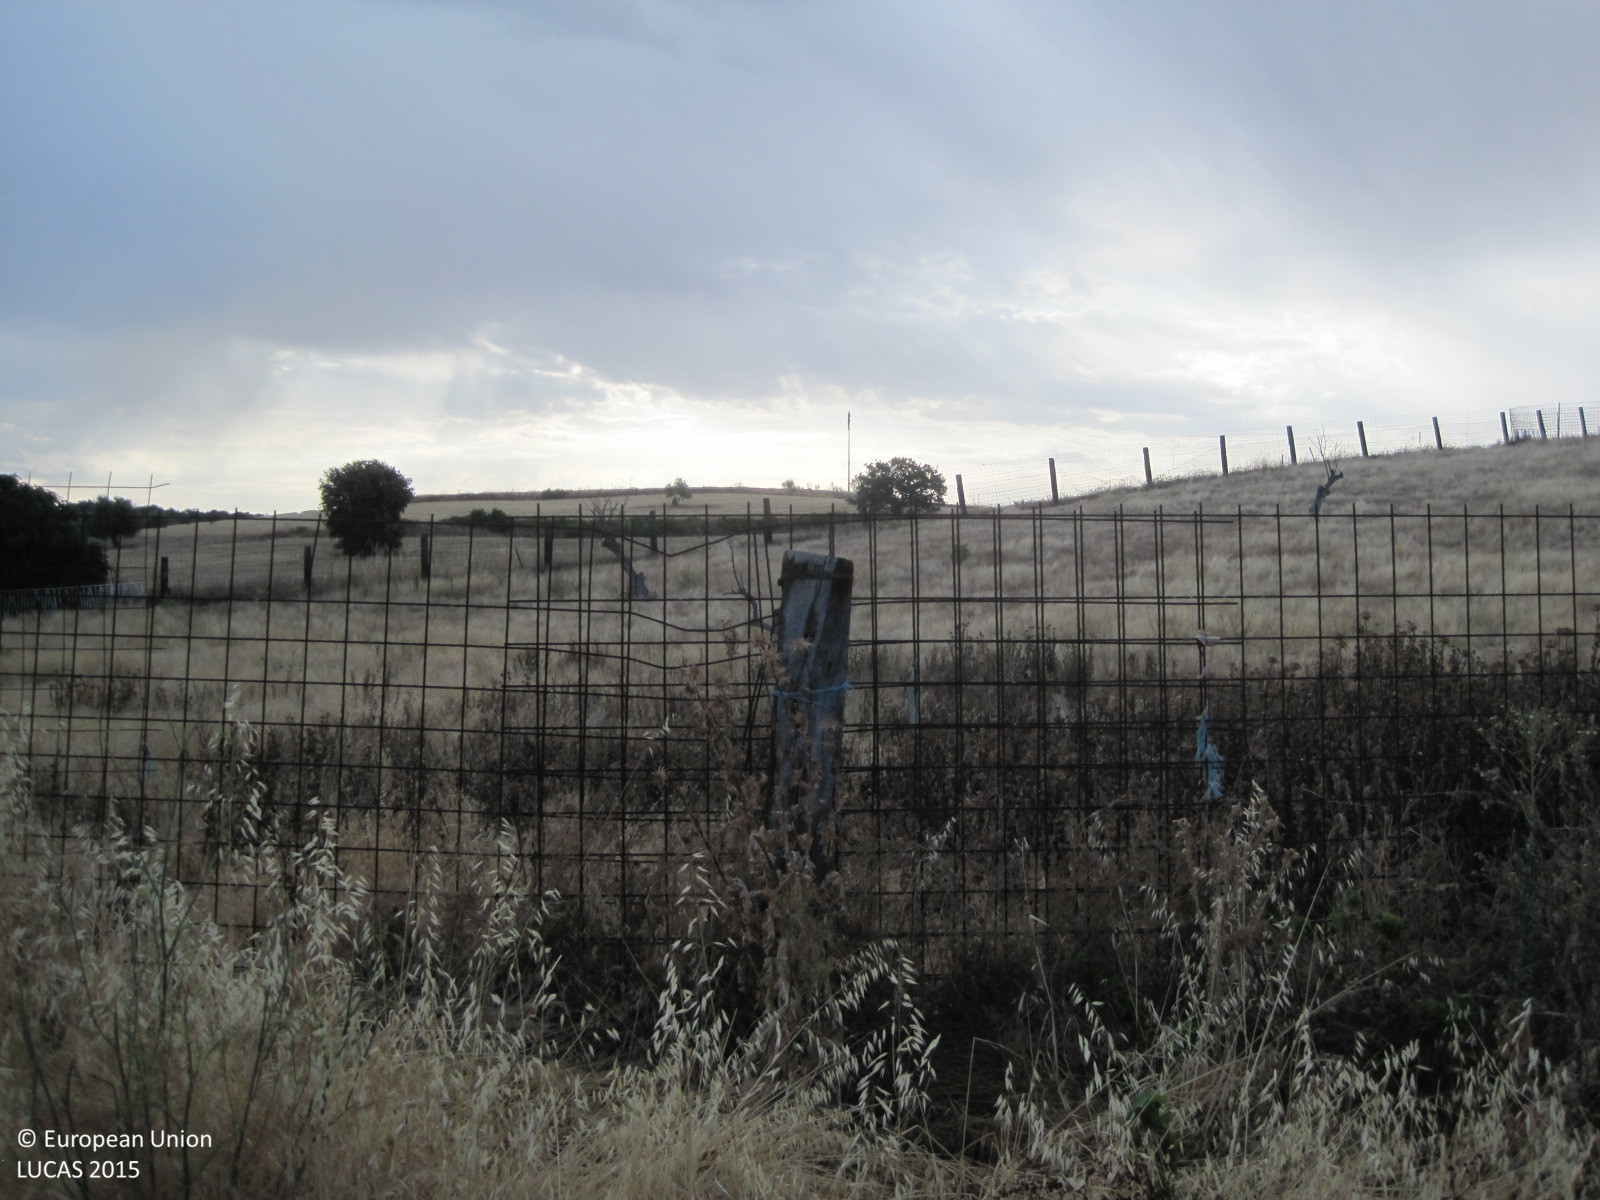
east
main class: Grassland
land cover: Grassland without tree/shrub cover
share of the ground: > 75 %
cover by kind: herbaceous plants 100 %
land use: Agriculture (excluding fallow land and kitchen gardens)
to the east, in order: Grassland without tree/shrub cover; Fences; Grassland with sparse tree/shrub cover; Fences; Grass margins; Tracks; Grass margins; Fences; Grassland without tree/shrub cover; Fences; Arable land (only in case pi); Shruby margins; Arable land (only in case pi)
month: July
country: ES
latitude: 40.0774
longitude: -4.2889
